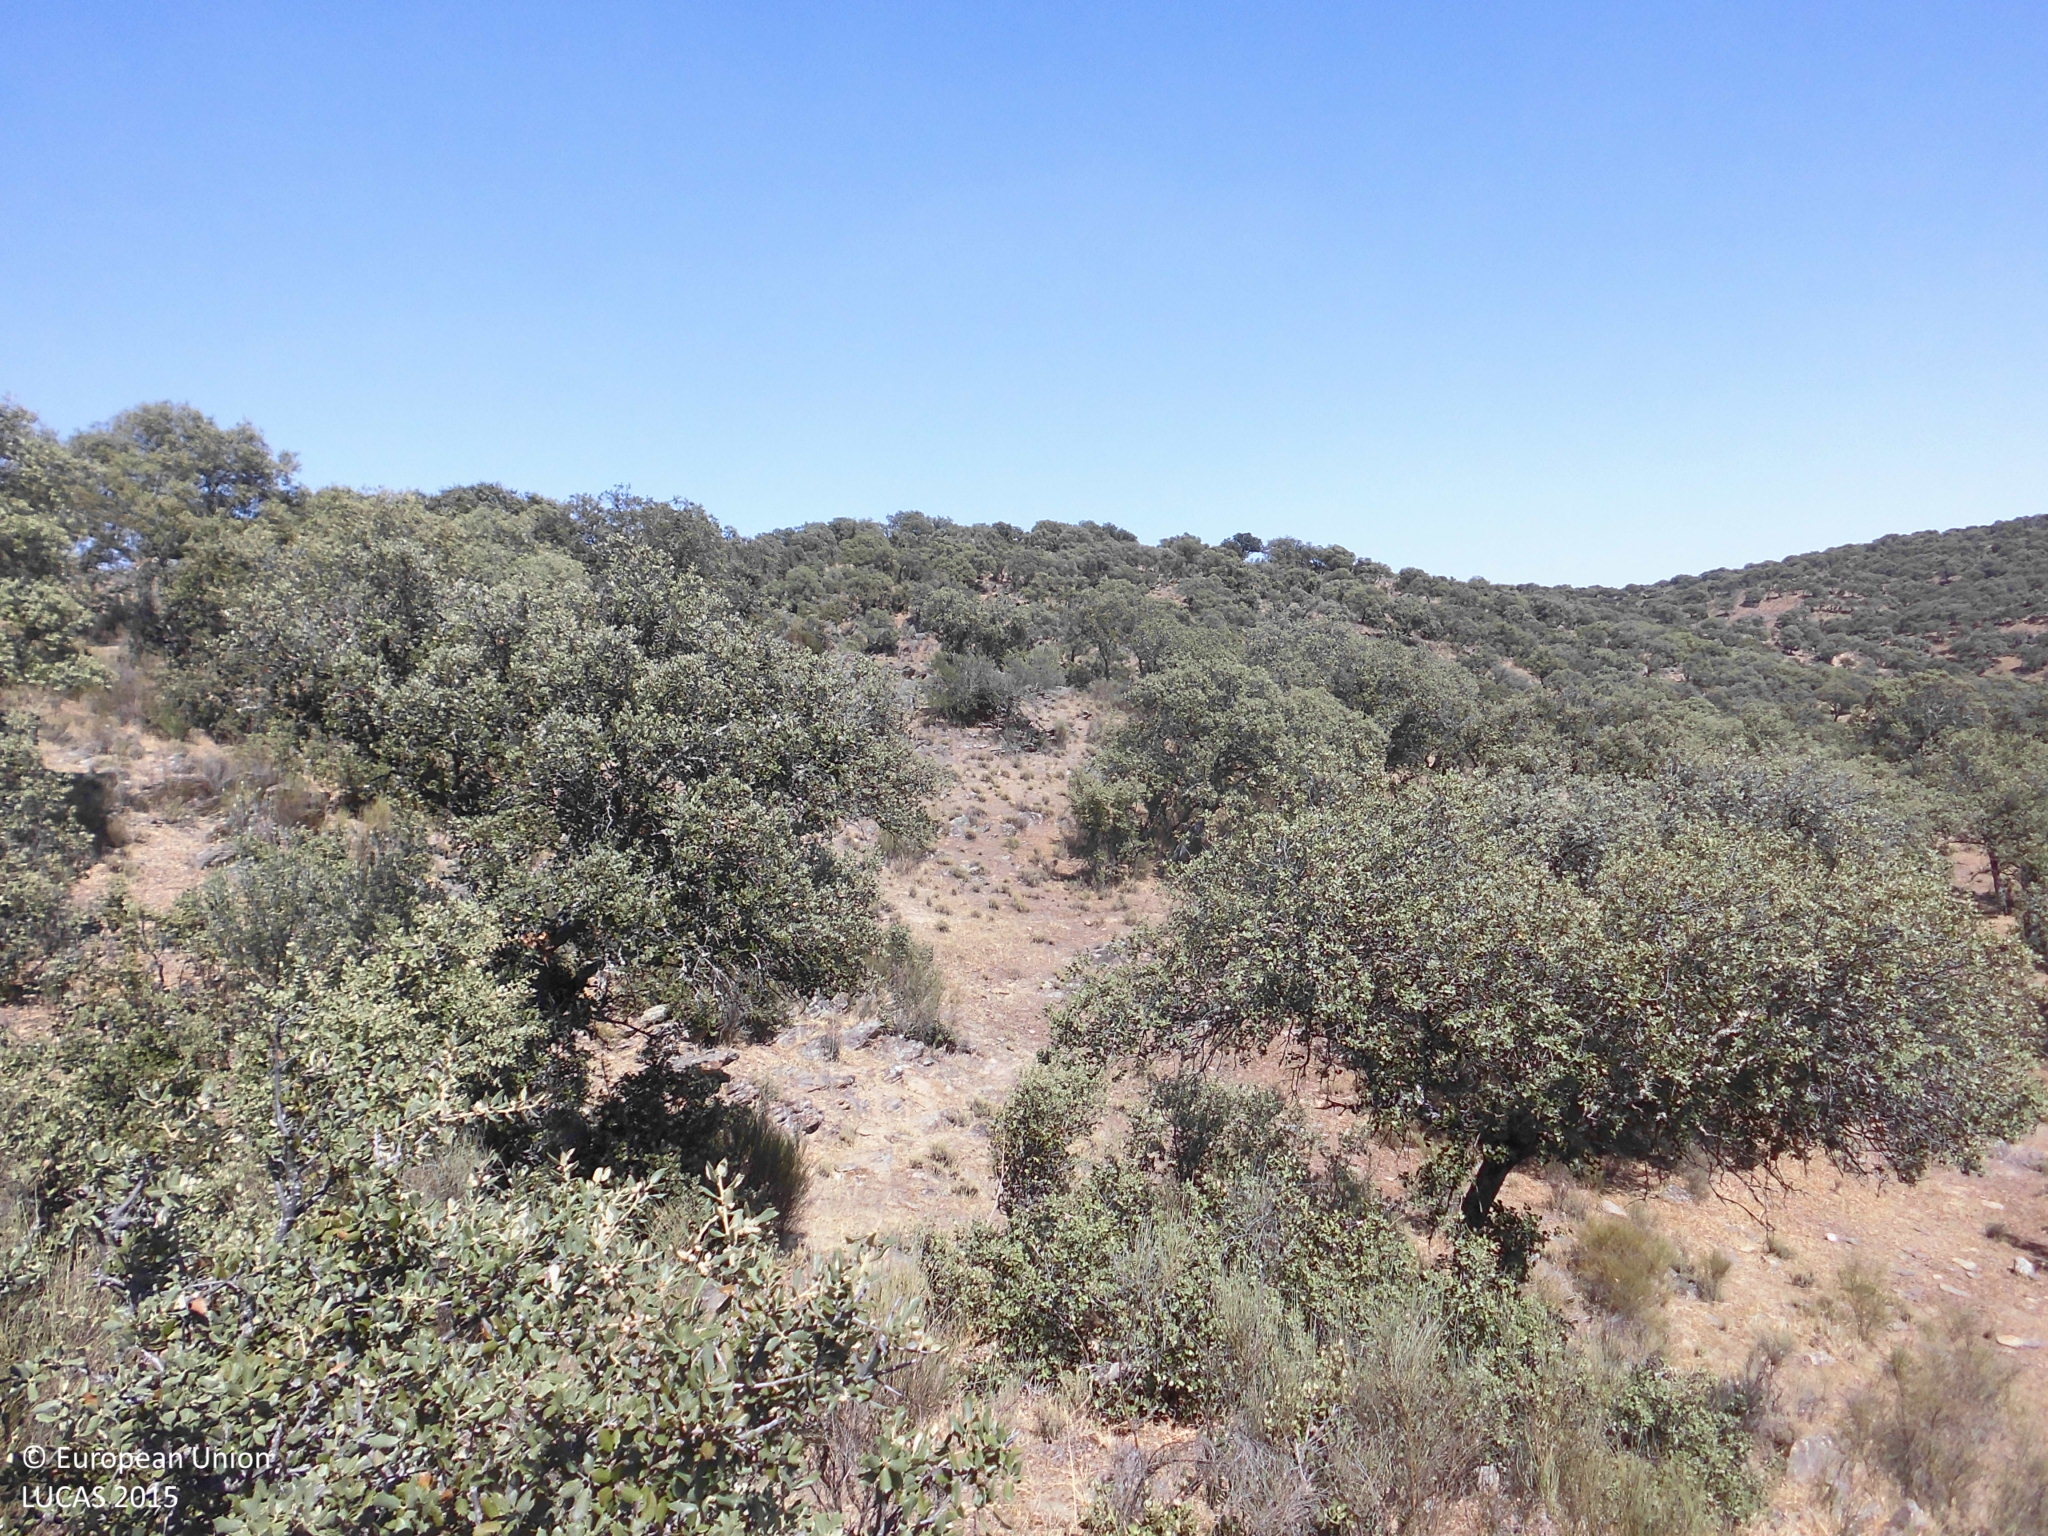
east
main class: Woodland
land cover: Broadleaved woodland
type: broadleaved evergreen forest
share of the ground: 10 - 25 %
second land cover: Shrubland without tree cover
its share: 25 - 50 %
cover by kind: herbaceous plants 45 %, broadleaved forest trees 25 %, shrubs 25 %, consolidated bare surface 5 %
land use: Forestry
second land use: Agriculture (excluding fallow land and kitchen gardens)
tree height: > 5 m
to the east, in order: Broadleaved woodland; Shrubland without tree cover; Rivers and streams; Broadleaved woodland
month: June
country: ES
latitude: 39.6289
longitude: -6.4171
